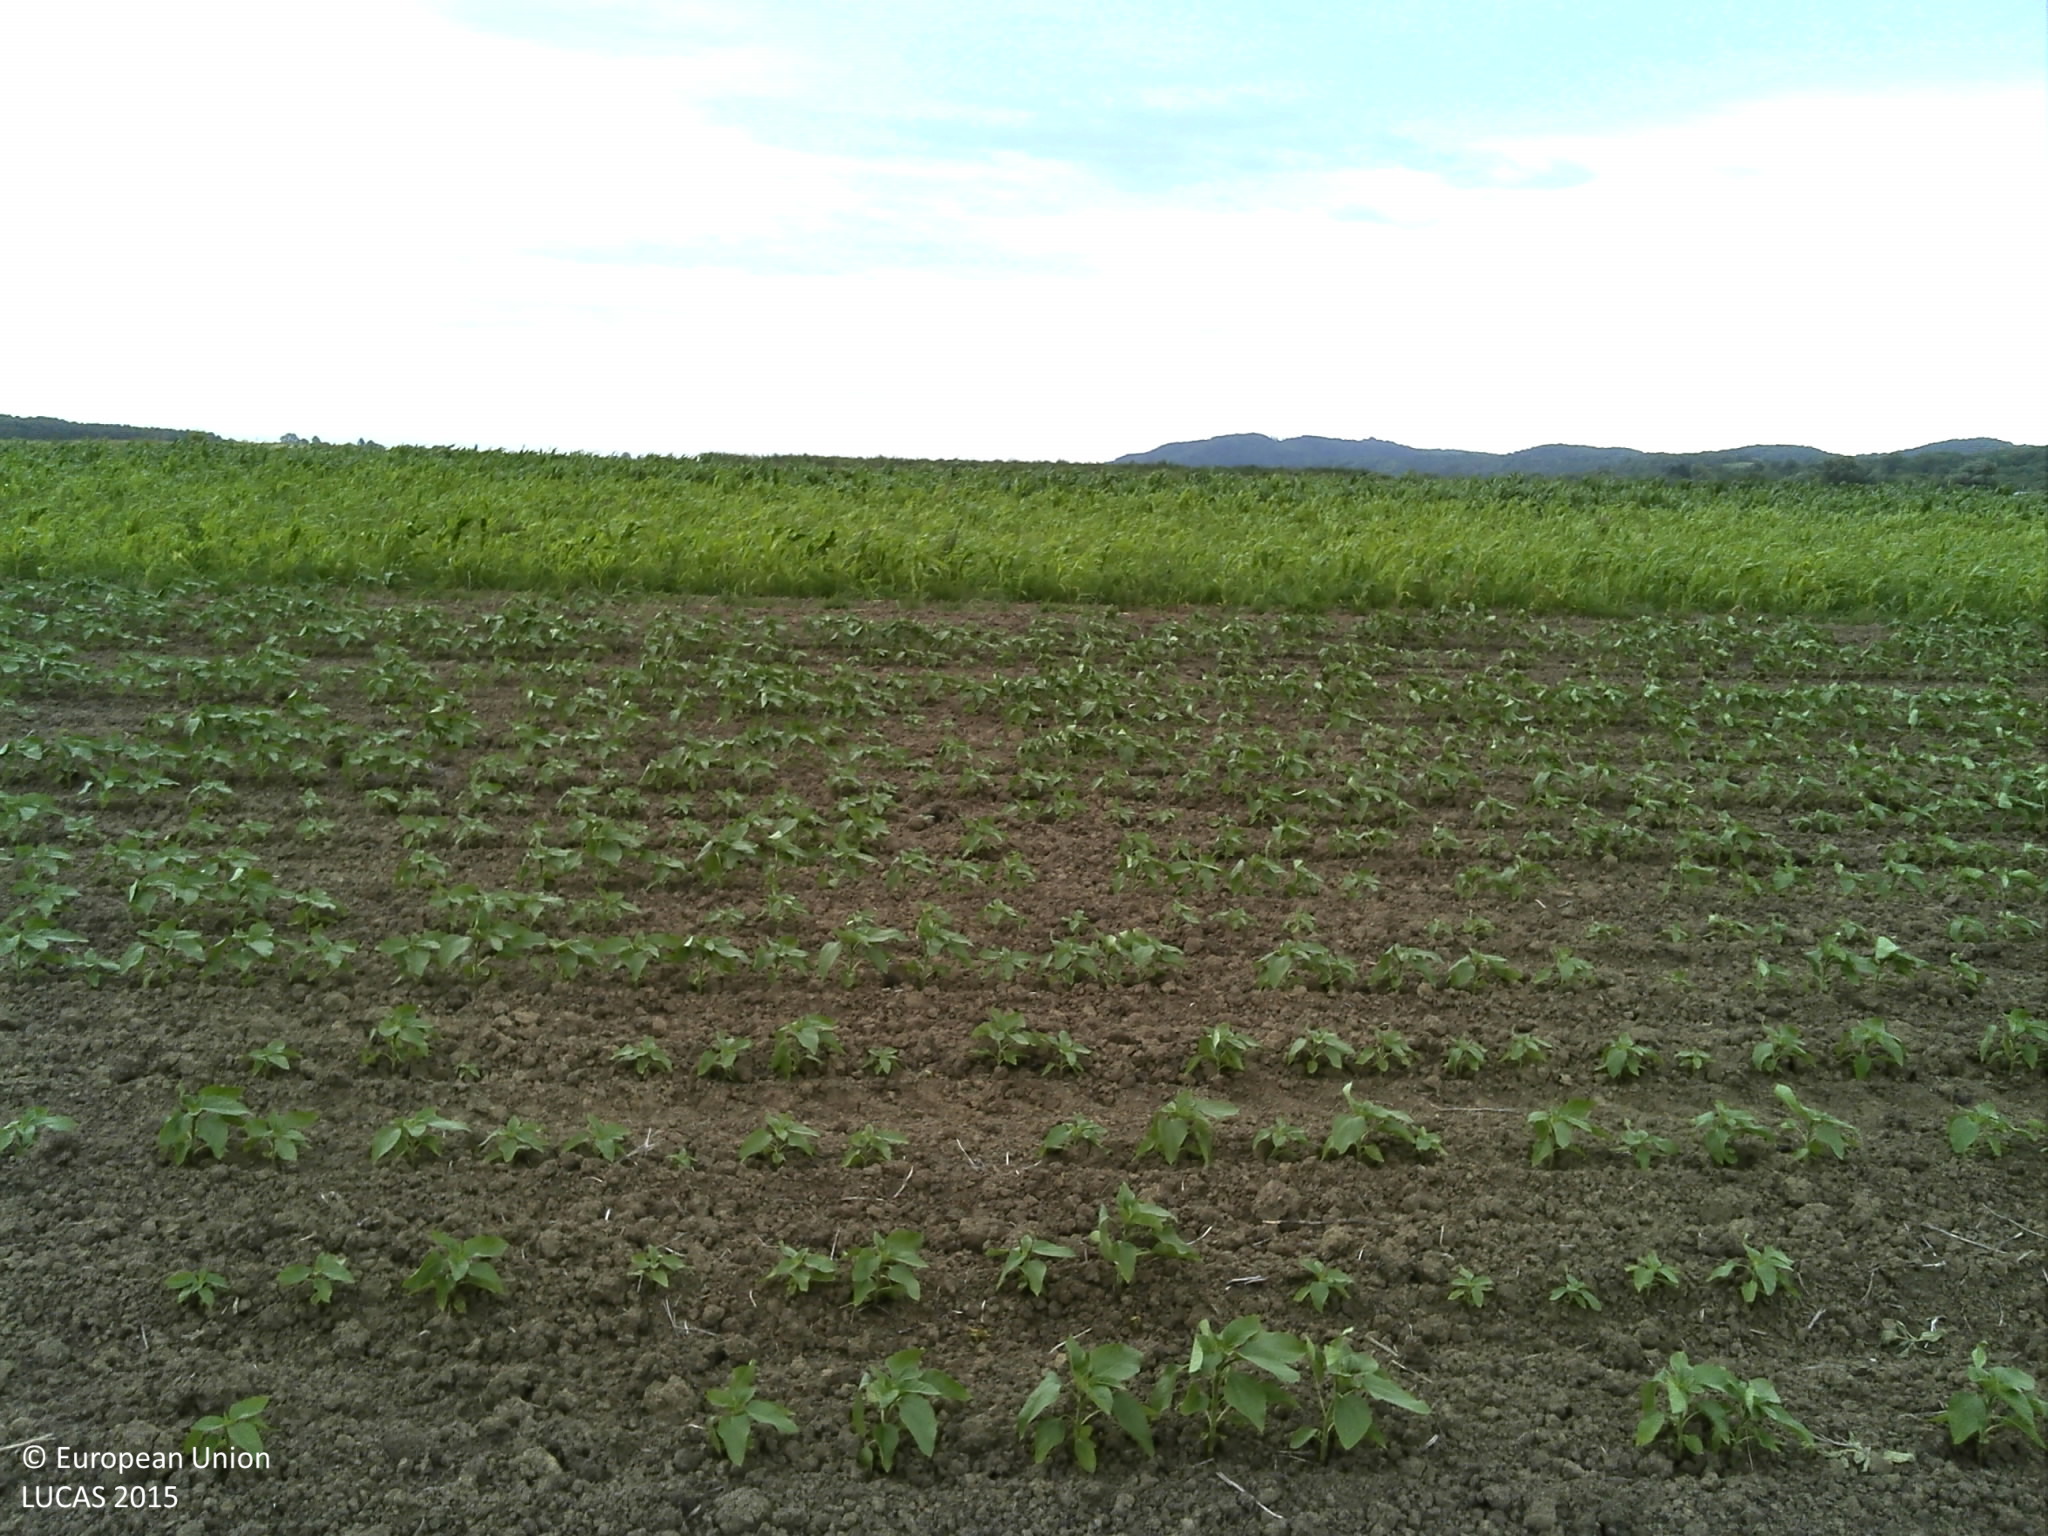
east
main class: Cropland
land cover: Sunflower
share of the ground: 10 - 25 %
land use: Agriculture (excluding fallow land and kitchen gardens)
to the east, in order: Sunflower; Maize; Ditches and canals; Spontaneously vegetated surfaces; Sunflower; Spontaneously vegetated surfaces
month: June
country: HR
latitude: 45.7801
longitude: 17.5008
